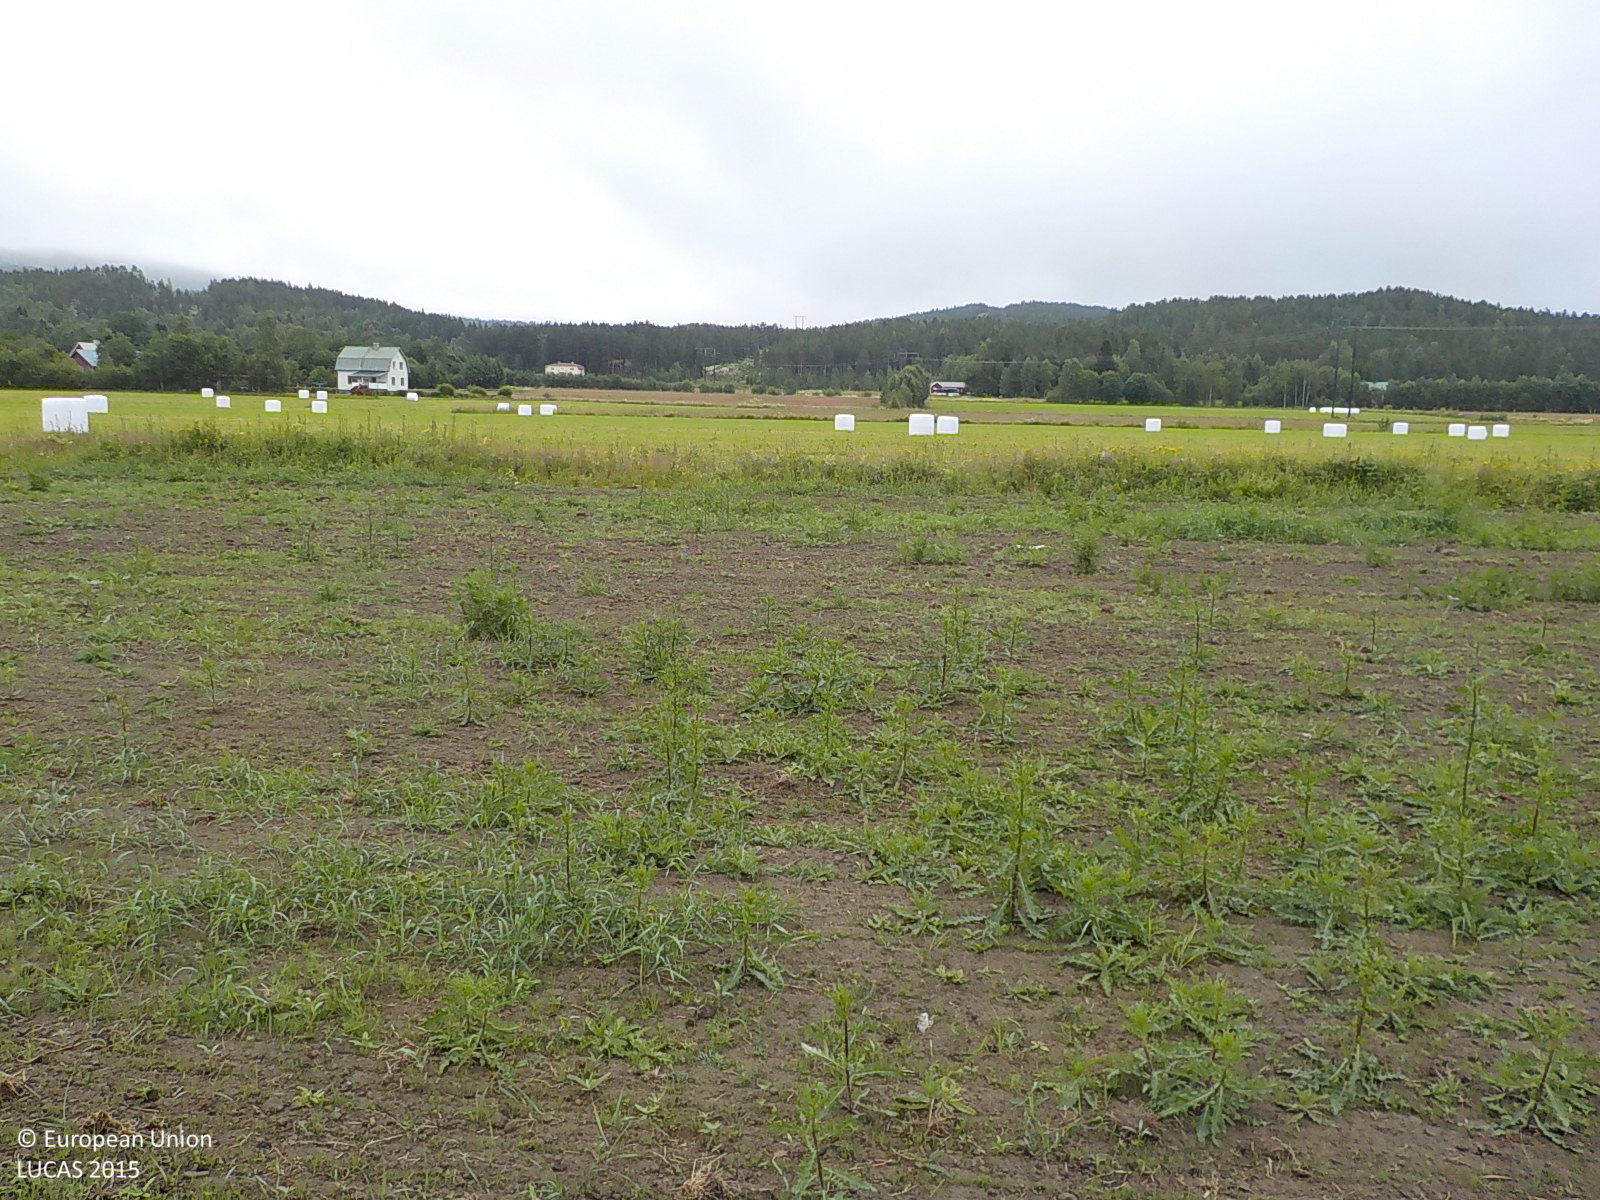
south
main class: Cropland
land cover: Other leguminous and mixtures for fodder
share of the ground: > 75 %
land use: Agriculture (excluding fallow land and kitchen gardens)
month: July
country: SE
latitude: 63.0255
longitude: 17.8226
